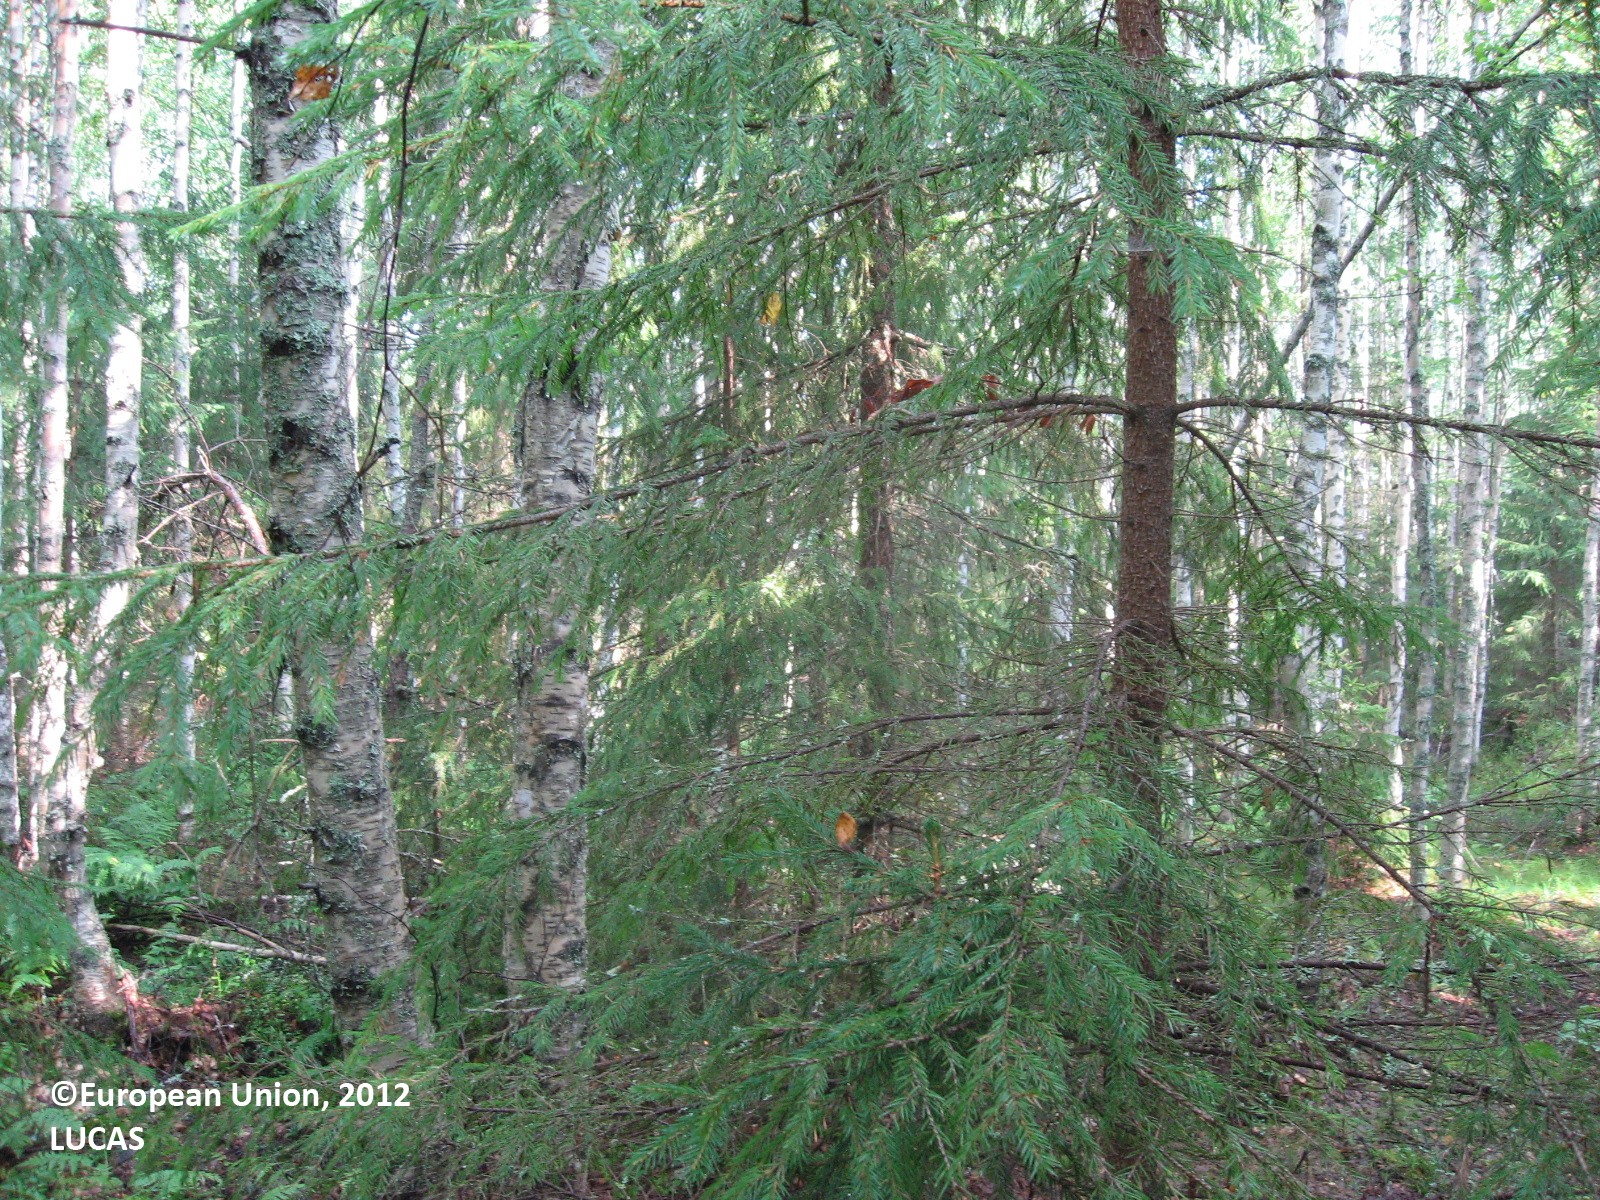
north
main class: Woodland
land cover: Spruce dominated mixed woodland
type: boreal forest
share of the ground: > 75 %
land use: Forestry
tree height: > 5 m
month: August
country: FI
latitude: 61.6052
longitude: 25.0968
